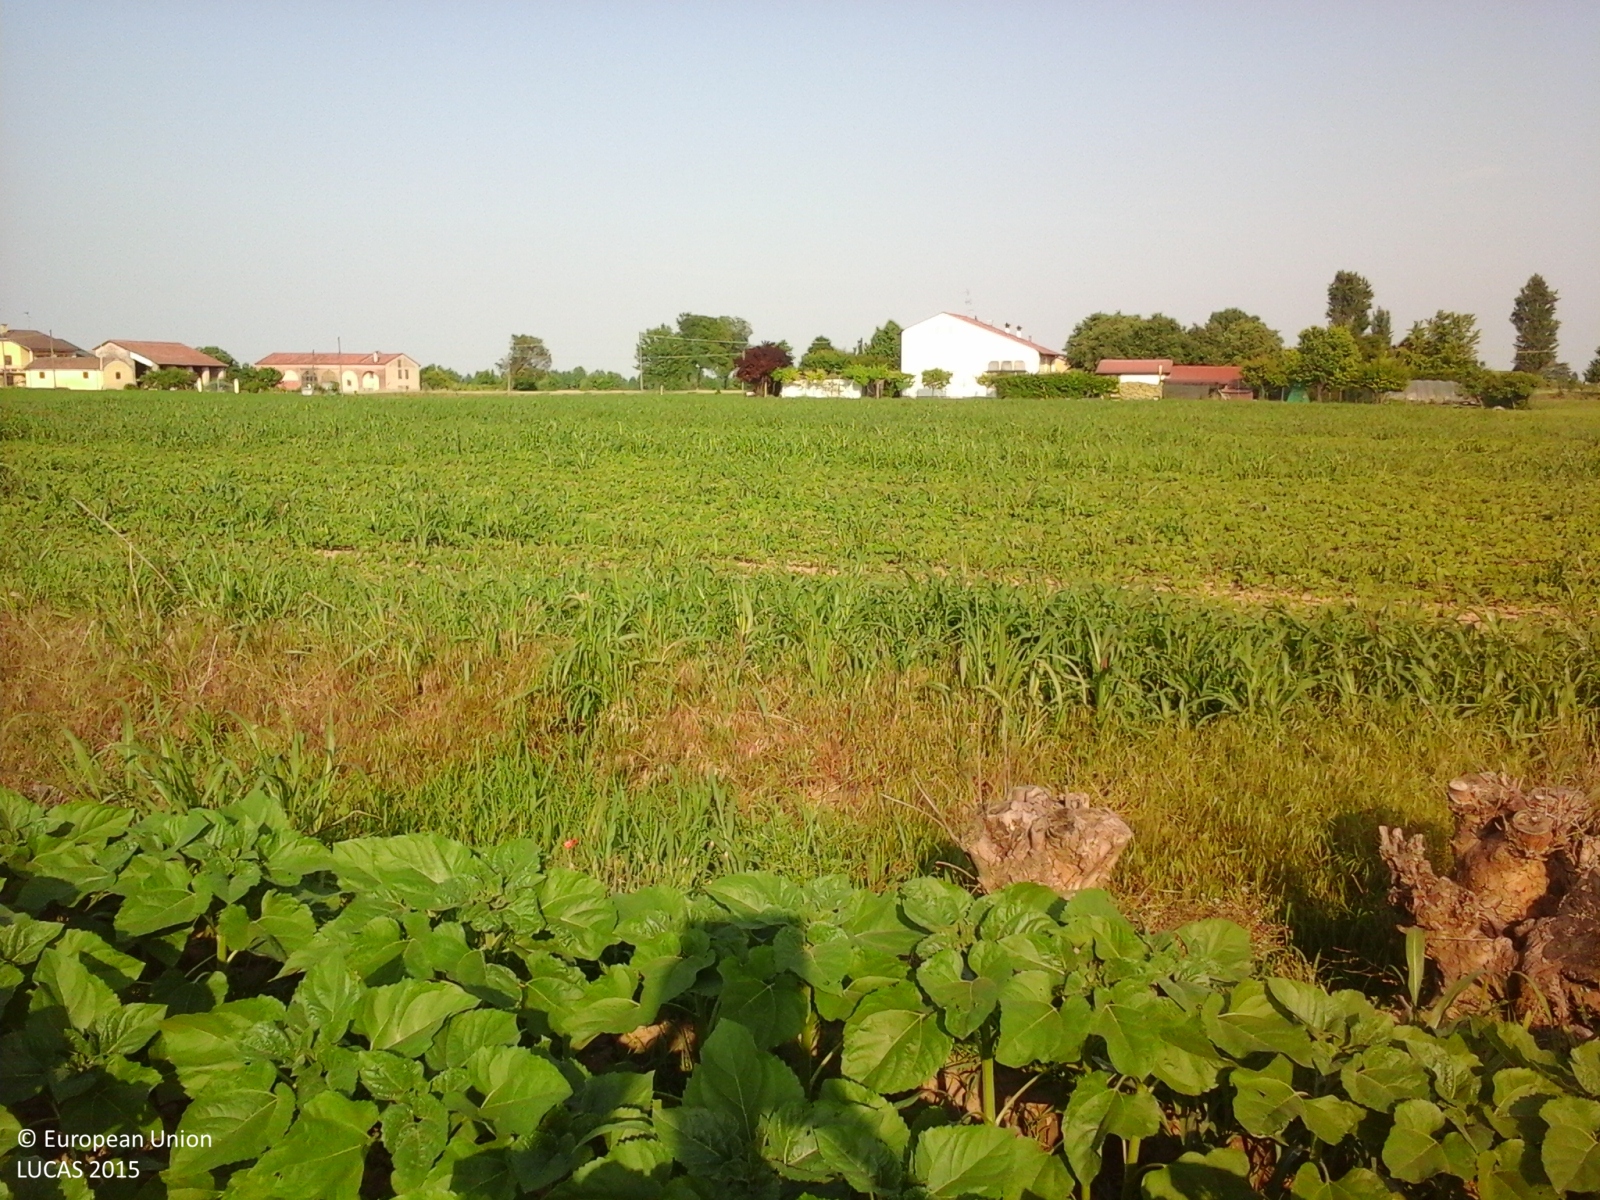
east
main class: Cropland
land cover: Sunflower
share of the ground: > 75 %
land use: Agriculture (excluding fallow land and kitchen gardens)
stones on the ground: < 10 %
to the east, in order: Sunflower; Ditches and canals; Managed hedges; Soya; Electric lines; Soya; Electric lines; Ditches and canals; Grass margins; Paved roads, cycling and walking lanes; Grass margins; Ditches and canals; Managed hedges; Common wheat
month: May
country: IT
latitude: 45.2302
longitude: 10.9027
